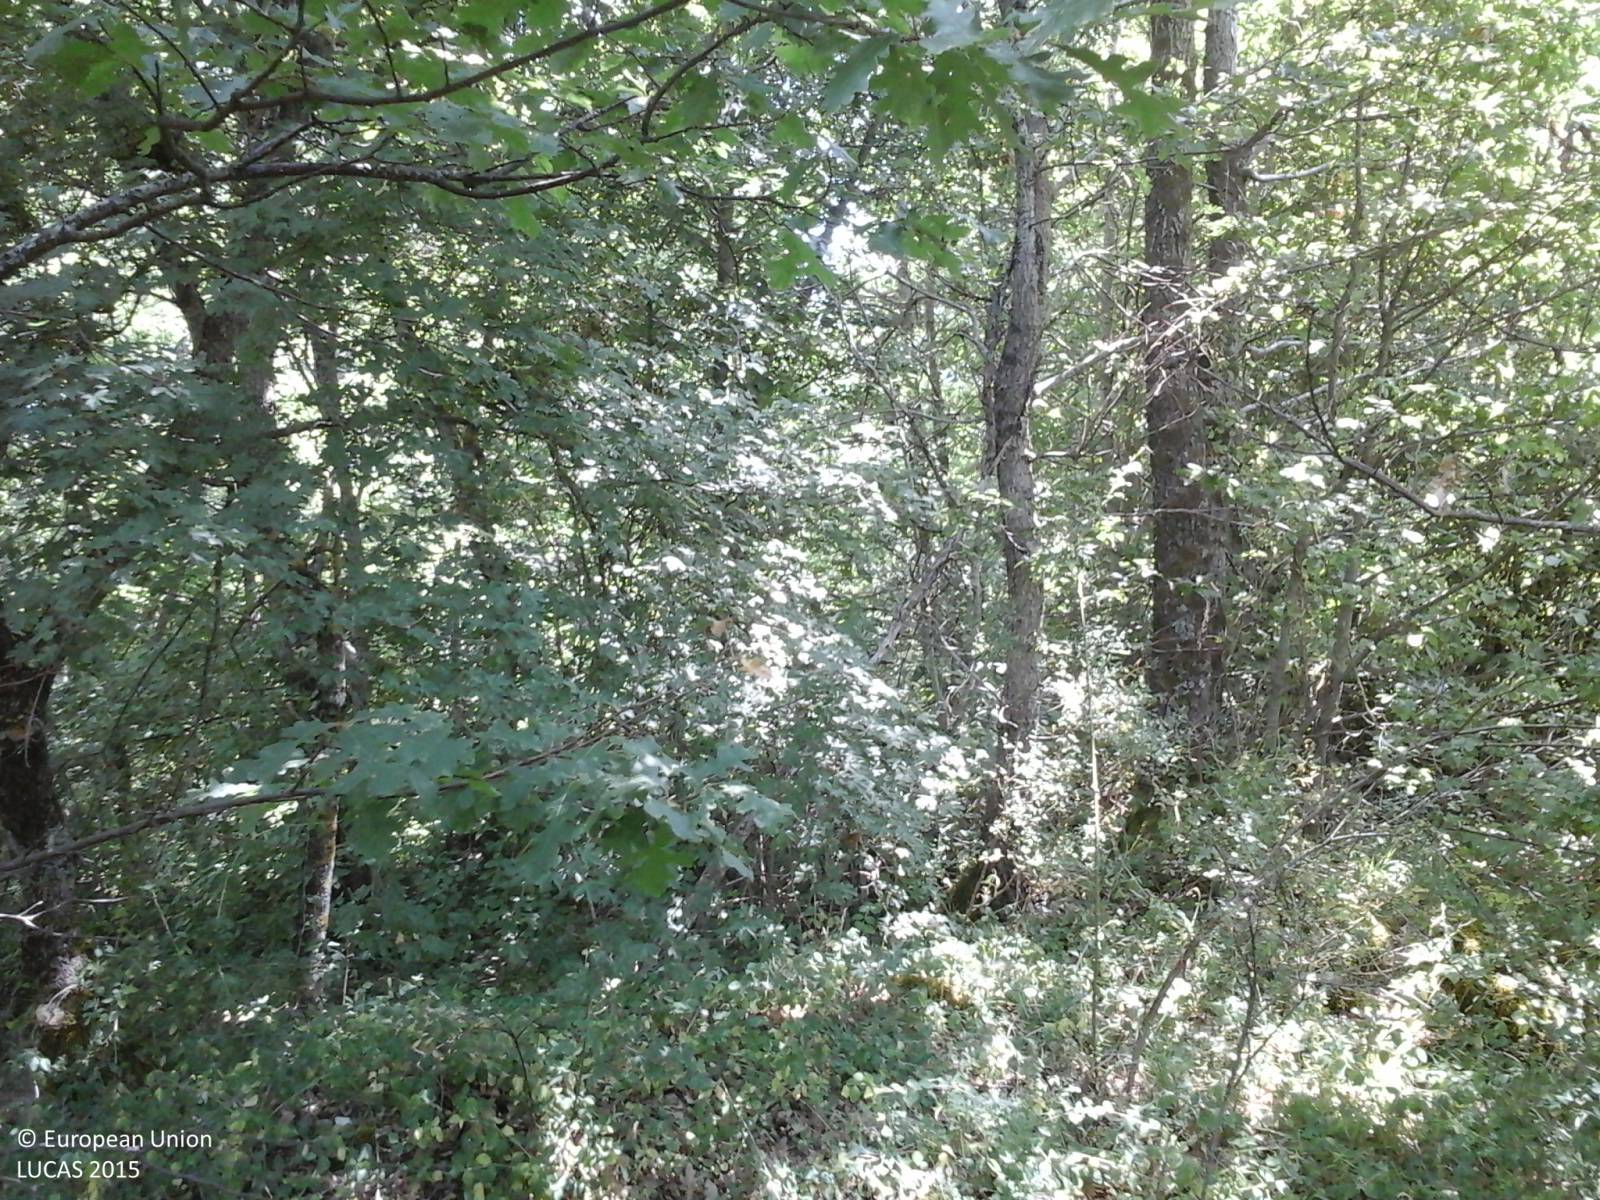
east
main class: Woodland
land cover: Broadleaved woodland
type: thermophilous deciduous forest
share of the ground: > 75 %
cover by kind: broadleaved forest trees 100 %
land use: Forestry
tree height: > 5 m
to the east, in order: Broadleaved woodland; Dry stone walls; Broadleaved woodland; Dry stone walls; Broadleaved woodland; Dry stone walls; Broadleaved woodland; Dry stone walls; Shrubland with sparse tree cover
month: July
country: IT
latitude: 42.4397
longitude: 13.2355
